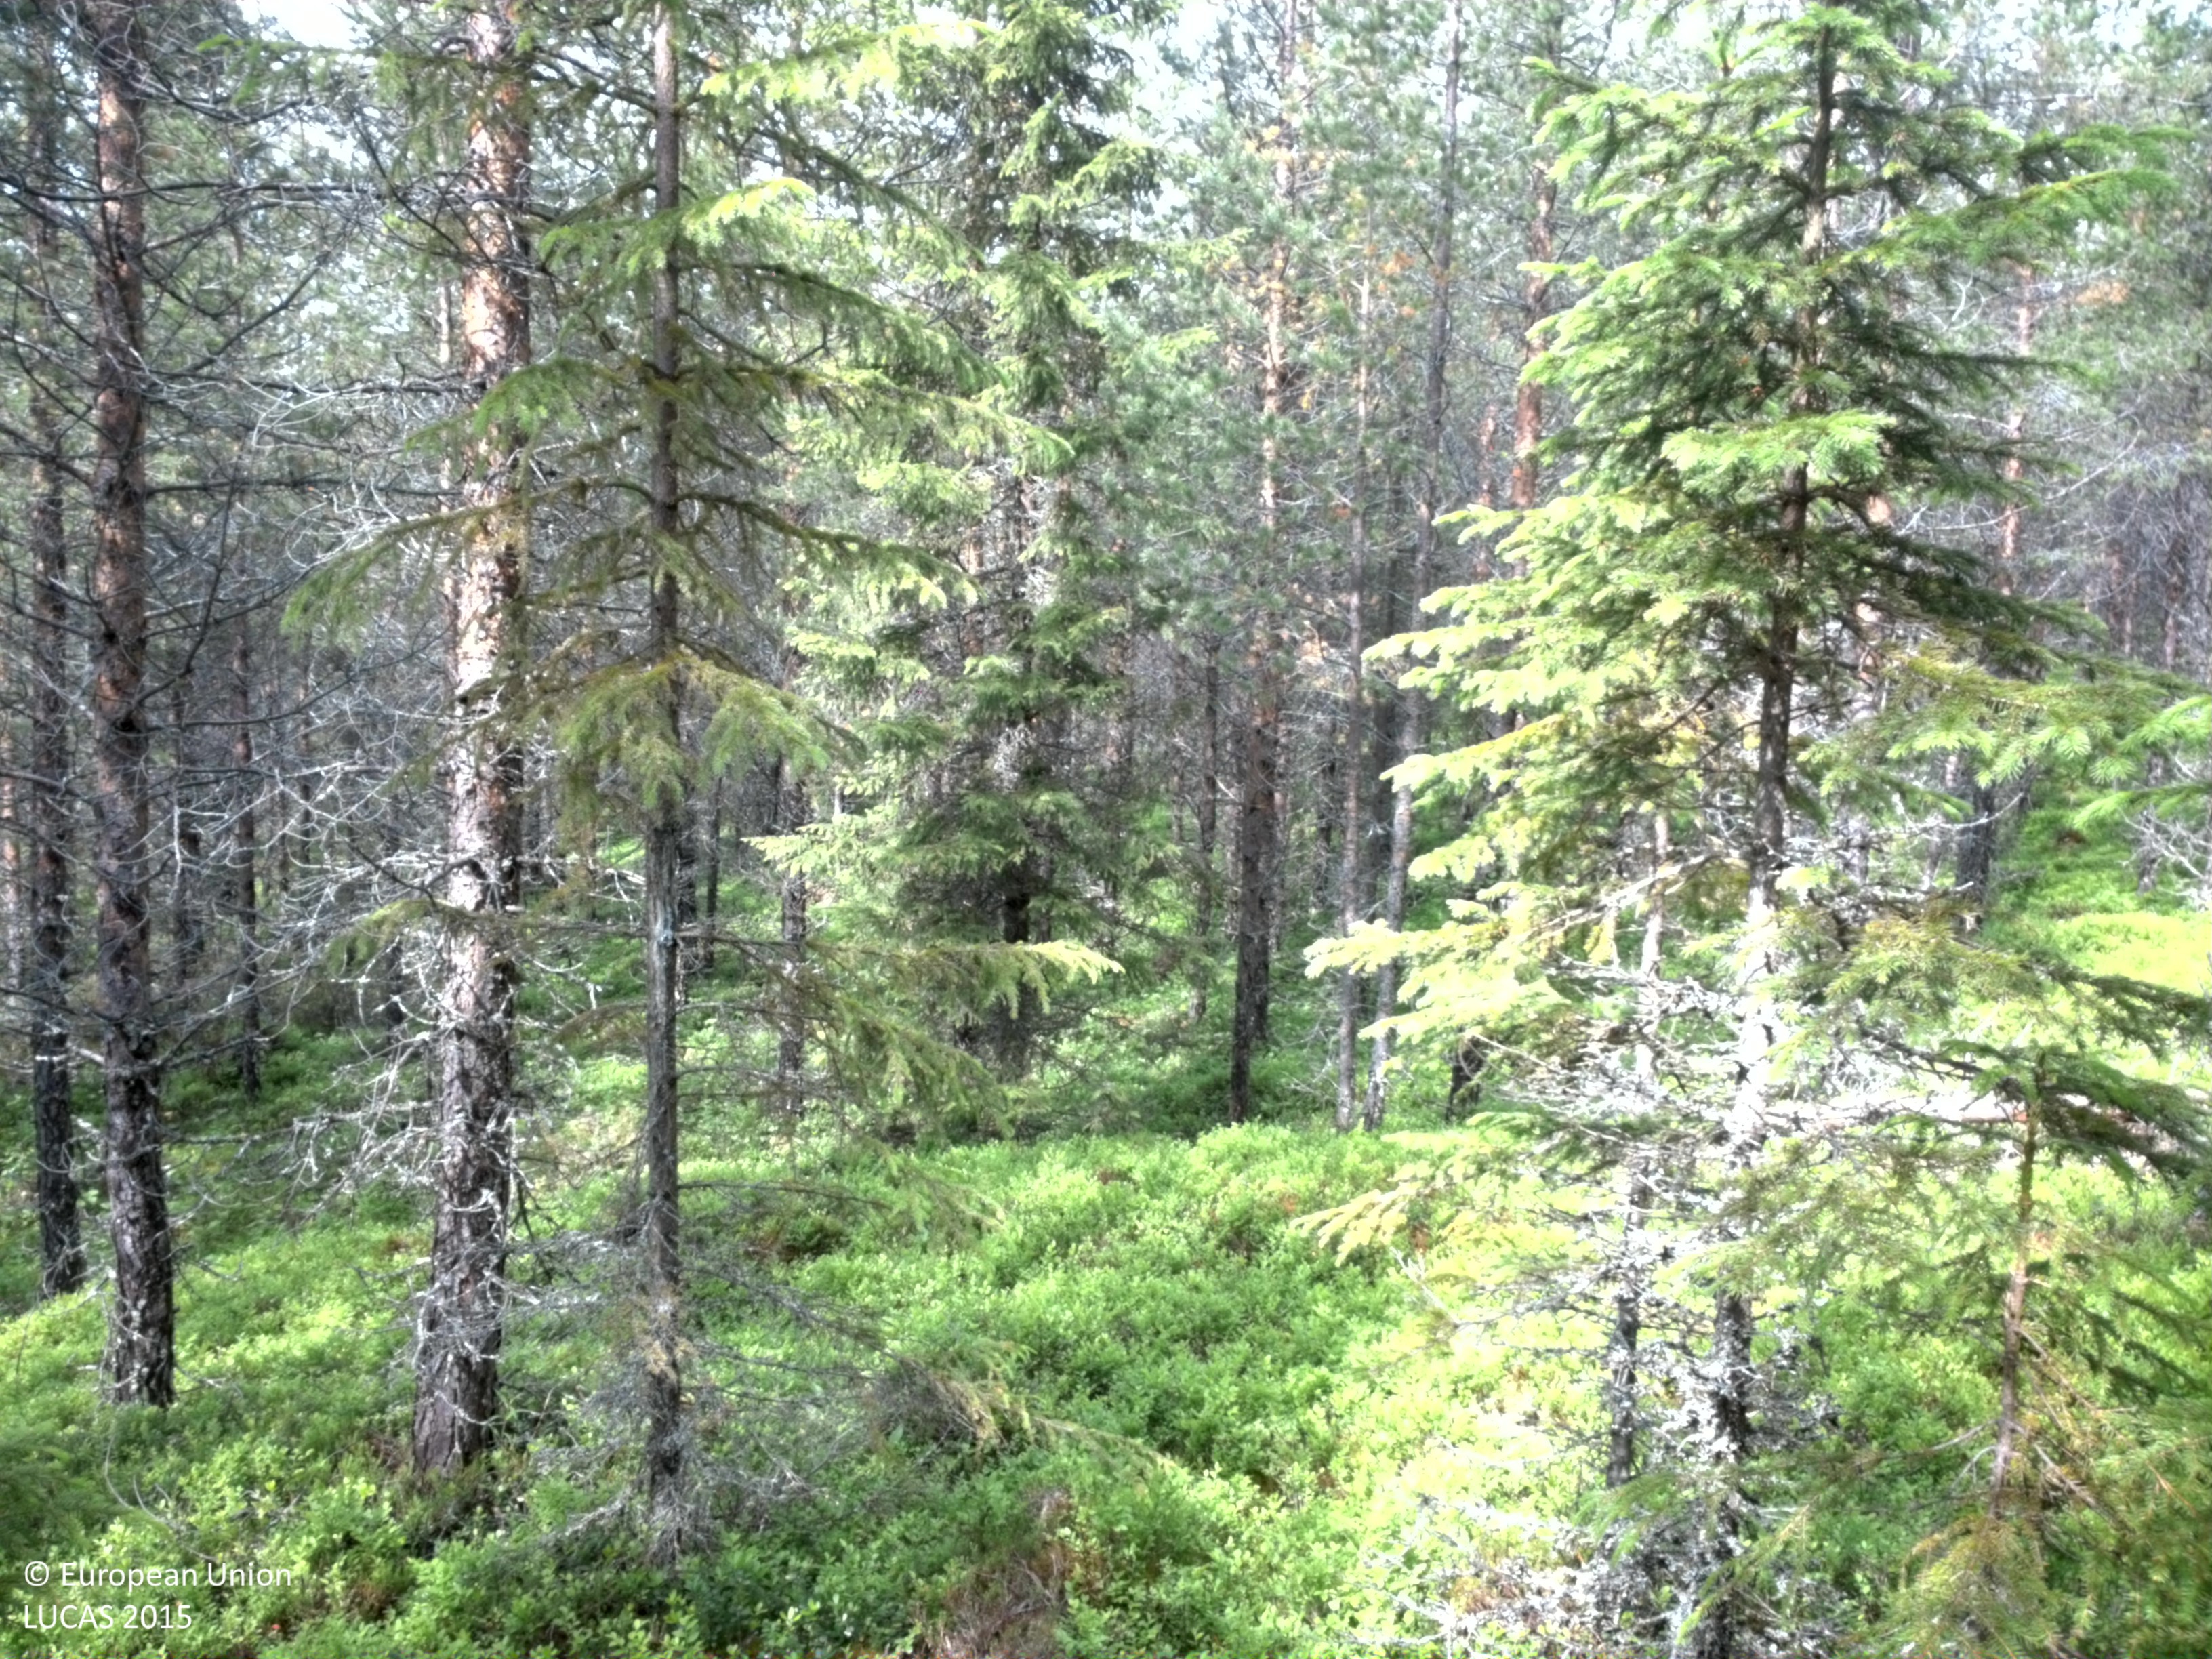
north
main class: Woodland
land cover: Pine dominated coniferous woodland
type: boreal forest
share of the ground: 50 - 75 %
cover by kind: coniferous forest trees 75 %, shrubs 25 %
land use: Forestry
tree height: > 5 m
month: July
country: SE
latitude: 64.7282
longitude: 18.2586
